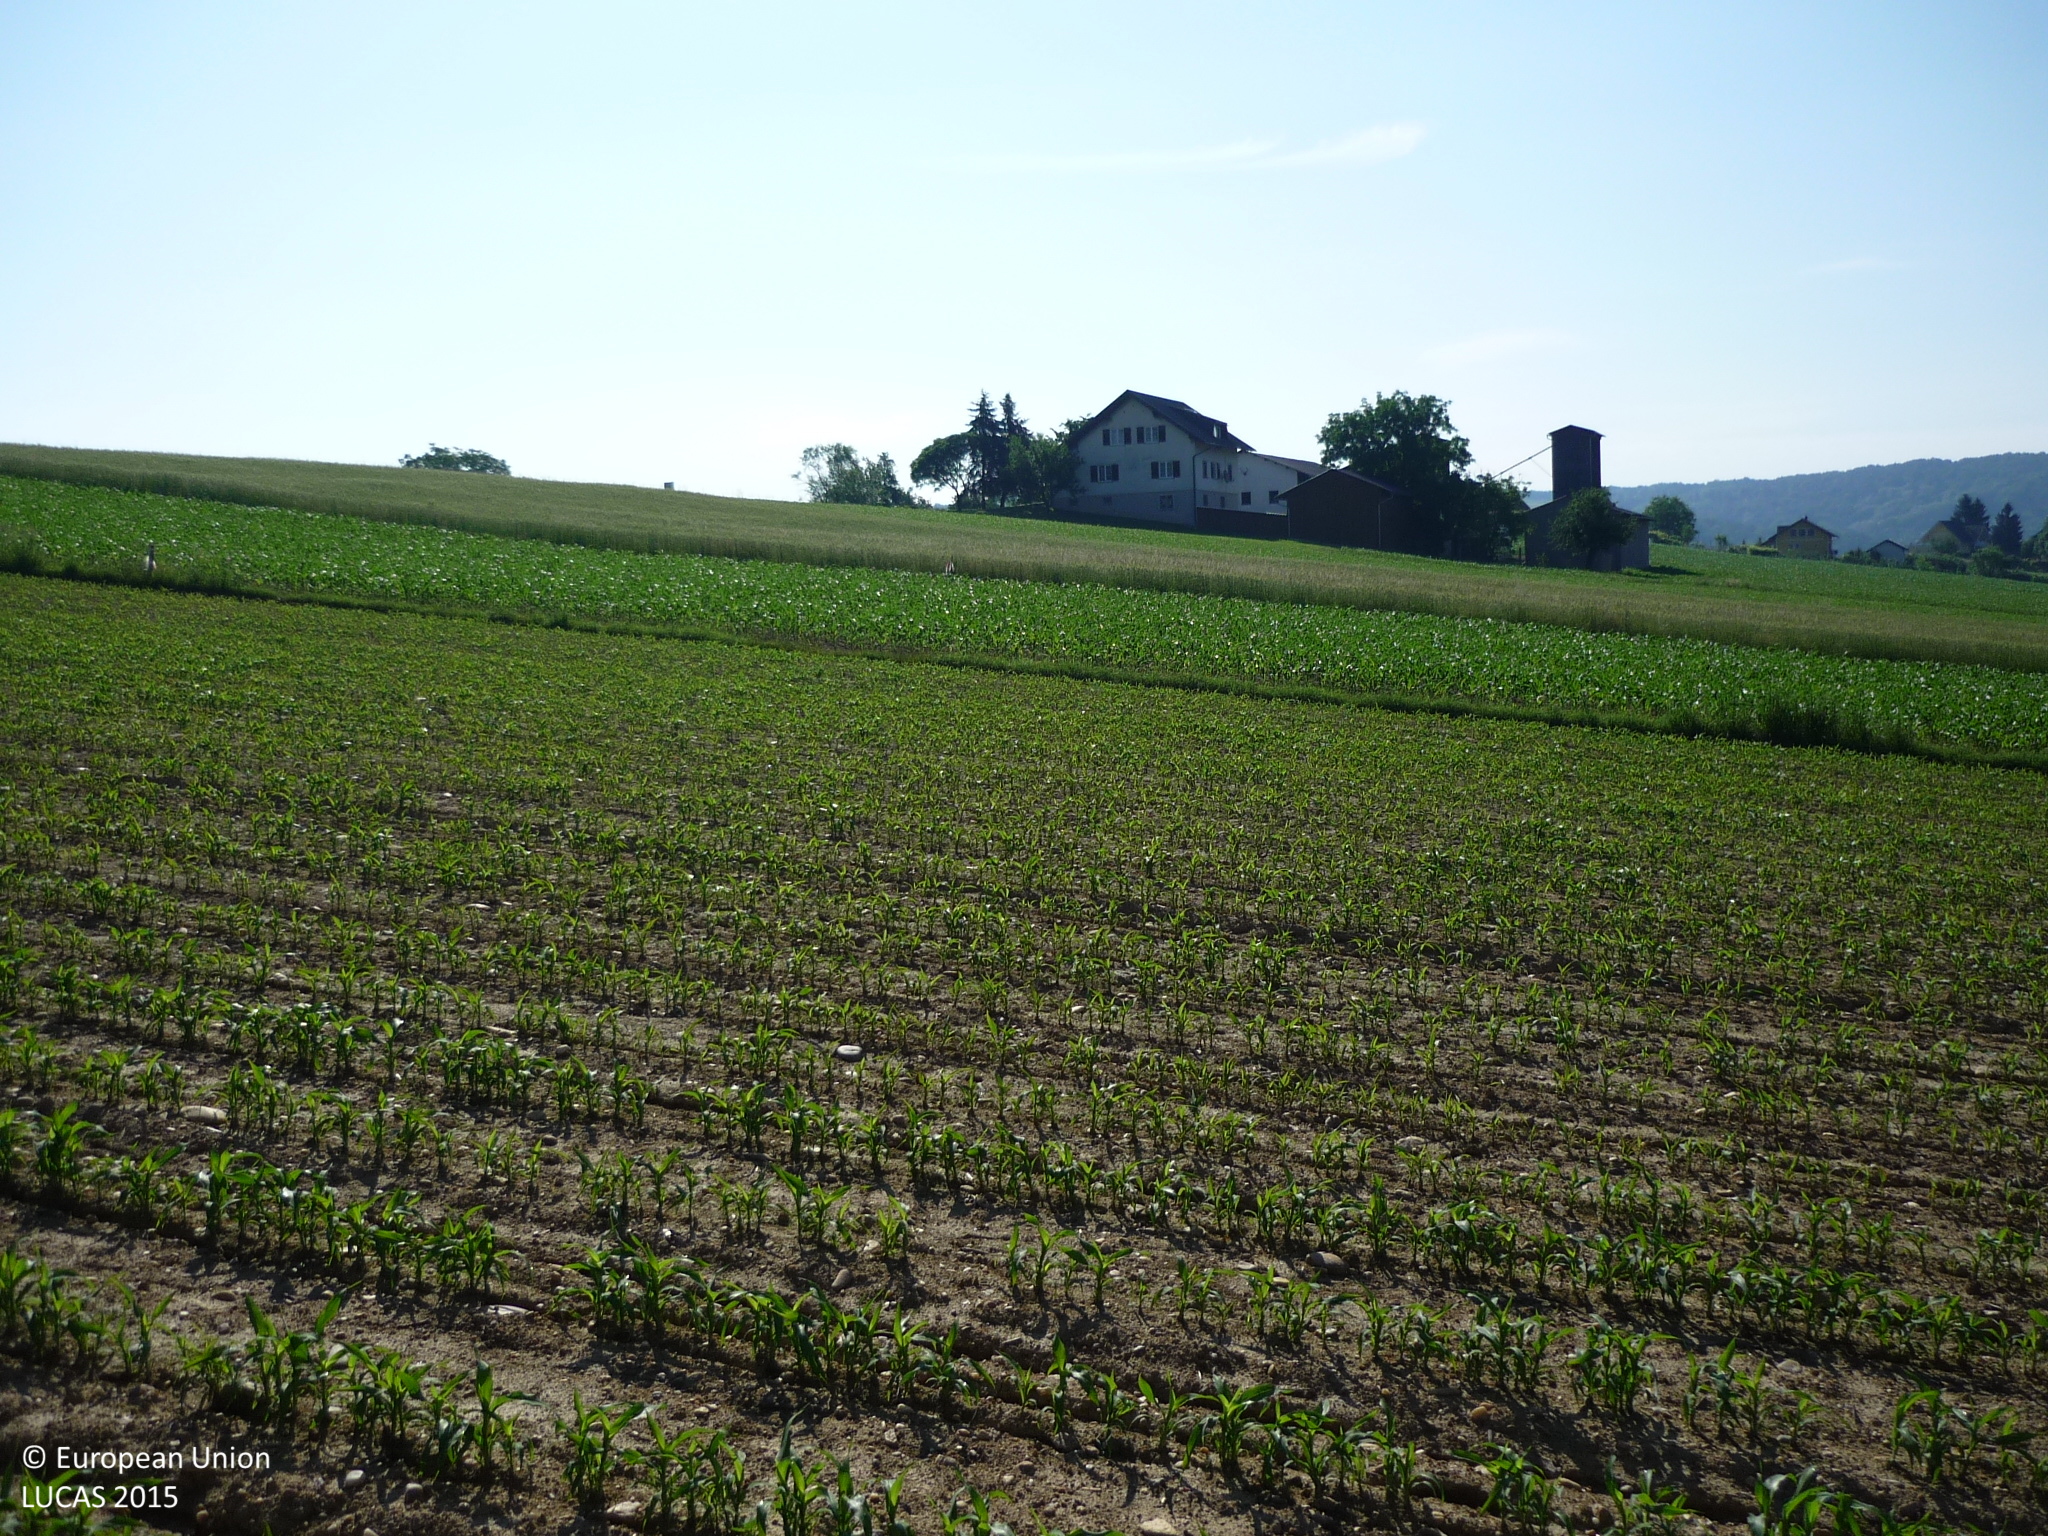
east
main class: Cropland
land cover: Maize
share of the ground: 25 - 50 %
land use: Agriculture (excluding fallow land and kitchen gardens)
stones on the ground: 10 - 25 %
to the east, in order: Maize; Grass margins; Maize; Common wheat; Maize; Ditches and canals; Paved roads, cycling and walking lanes; Ditches and canals; Common wheat; Grassland with sparse tree/shrub cover; Paved roads, cycling and walking lanes; Rye
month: June
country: AT
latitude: 46.8130
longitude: 15.7007
